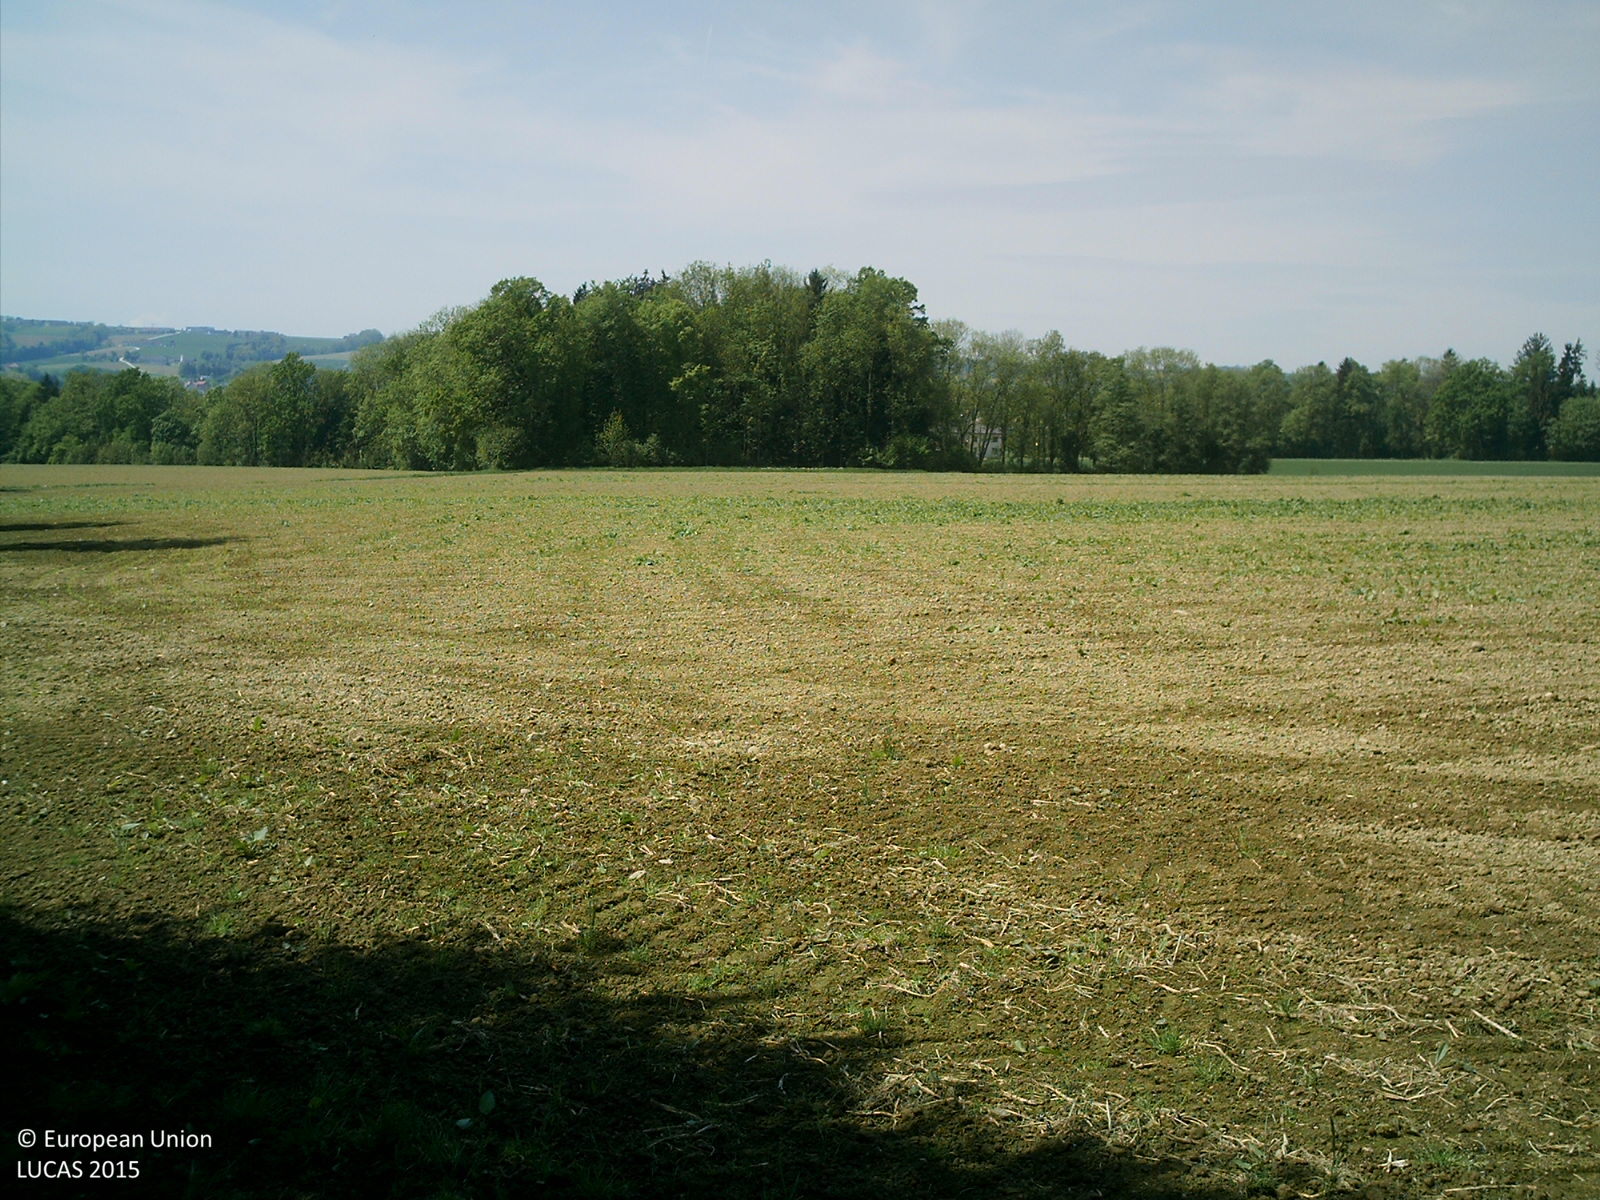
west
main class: Grassland
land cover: Spontaneously vegetated surfaces
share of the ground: > 75 %
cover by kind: herbaceous plants 100 %
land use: Fallow land
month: May
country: AT
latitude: 47.9837
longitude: 14.1396
